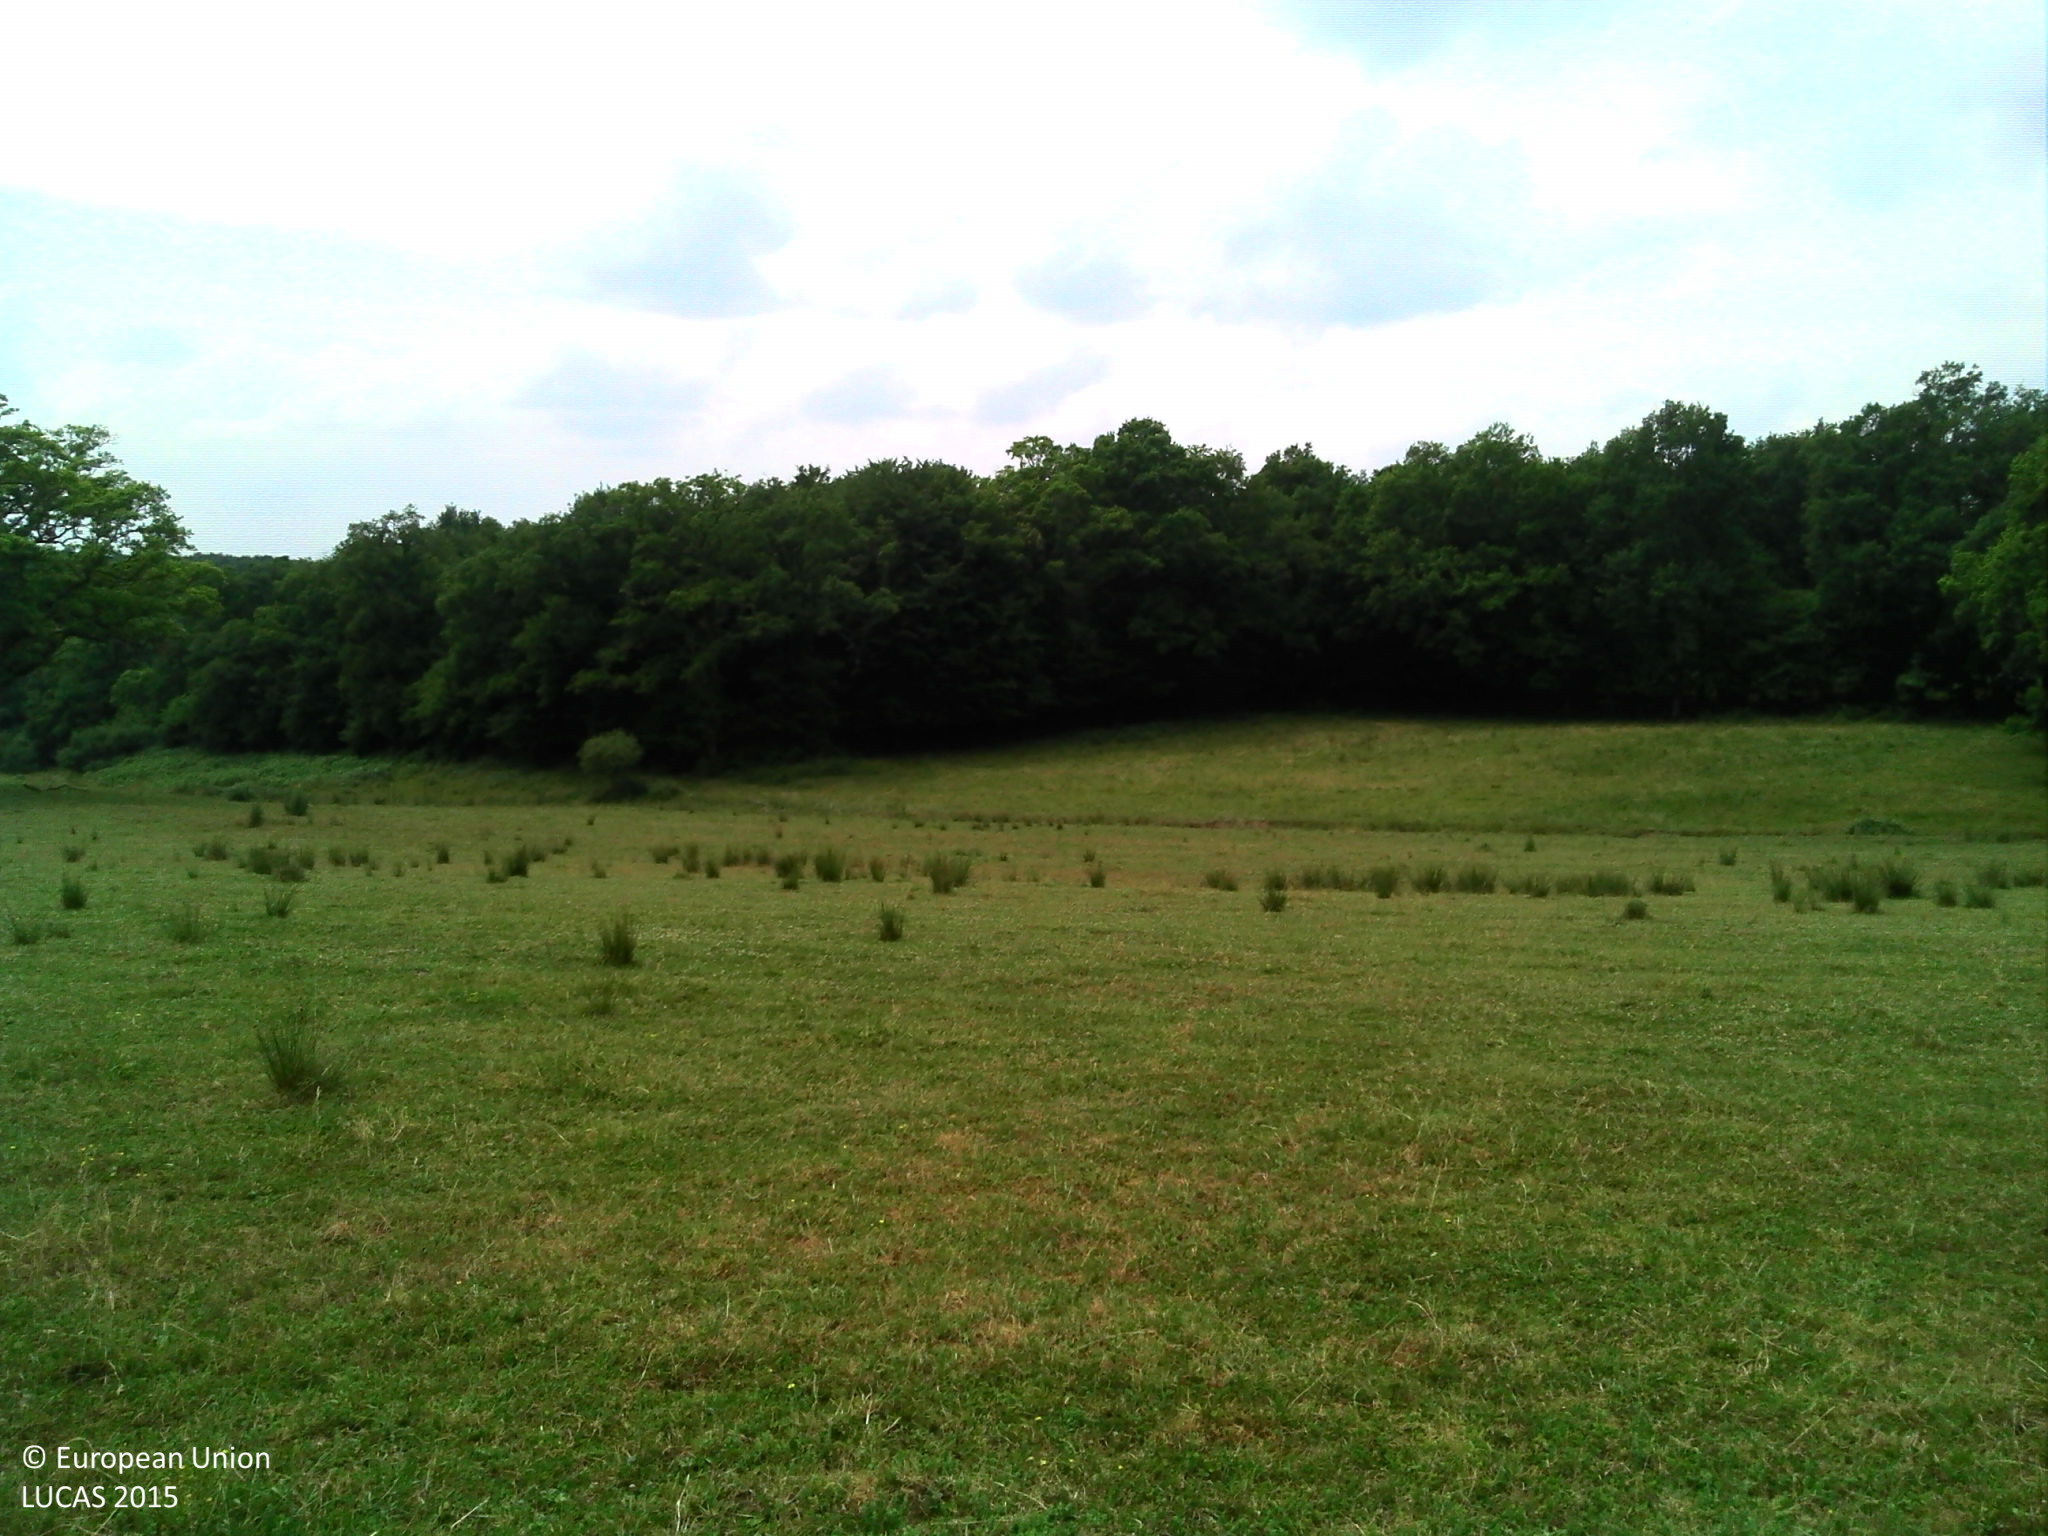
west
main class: Grassland
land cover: Grassland without tree/shrub cover
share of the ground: > 75 %
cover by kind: herbaceous plants 100 %
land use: Agriculture (excluding fallow land and kitchen gardens)
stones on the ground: < 10 %
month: June
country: FR
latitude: 46.0109
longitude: 0.6223
